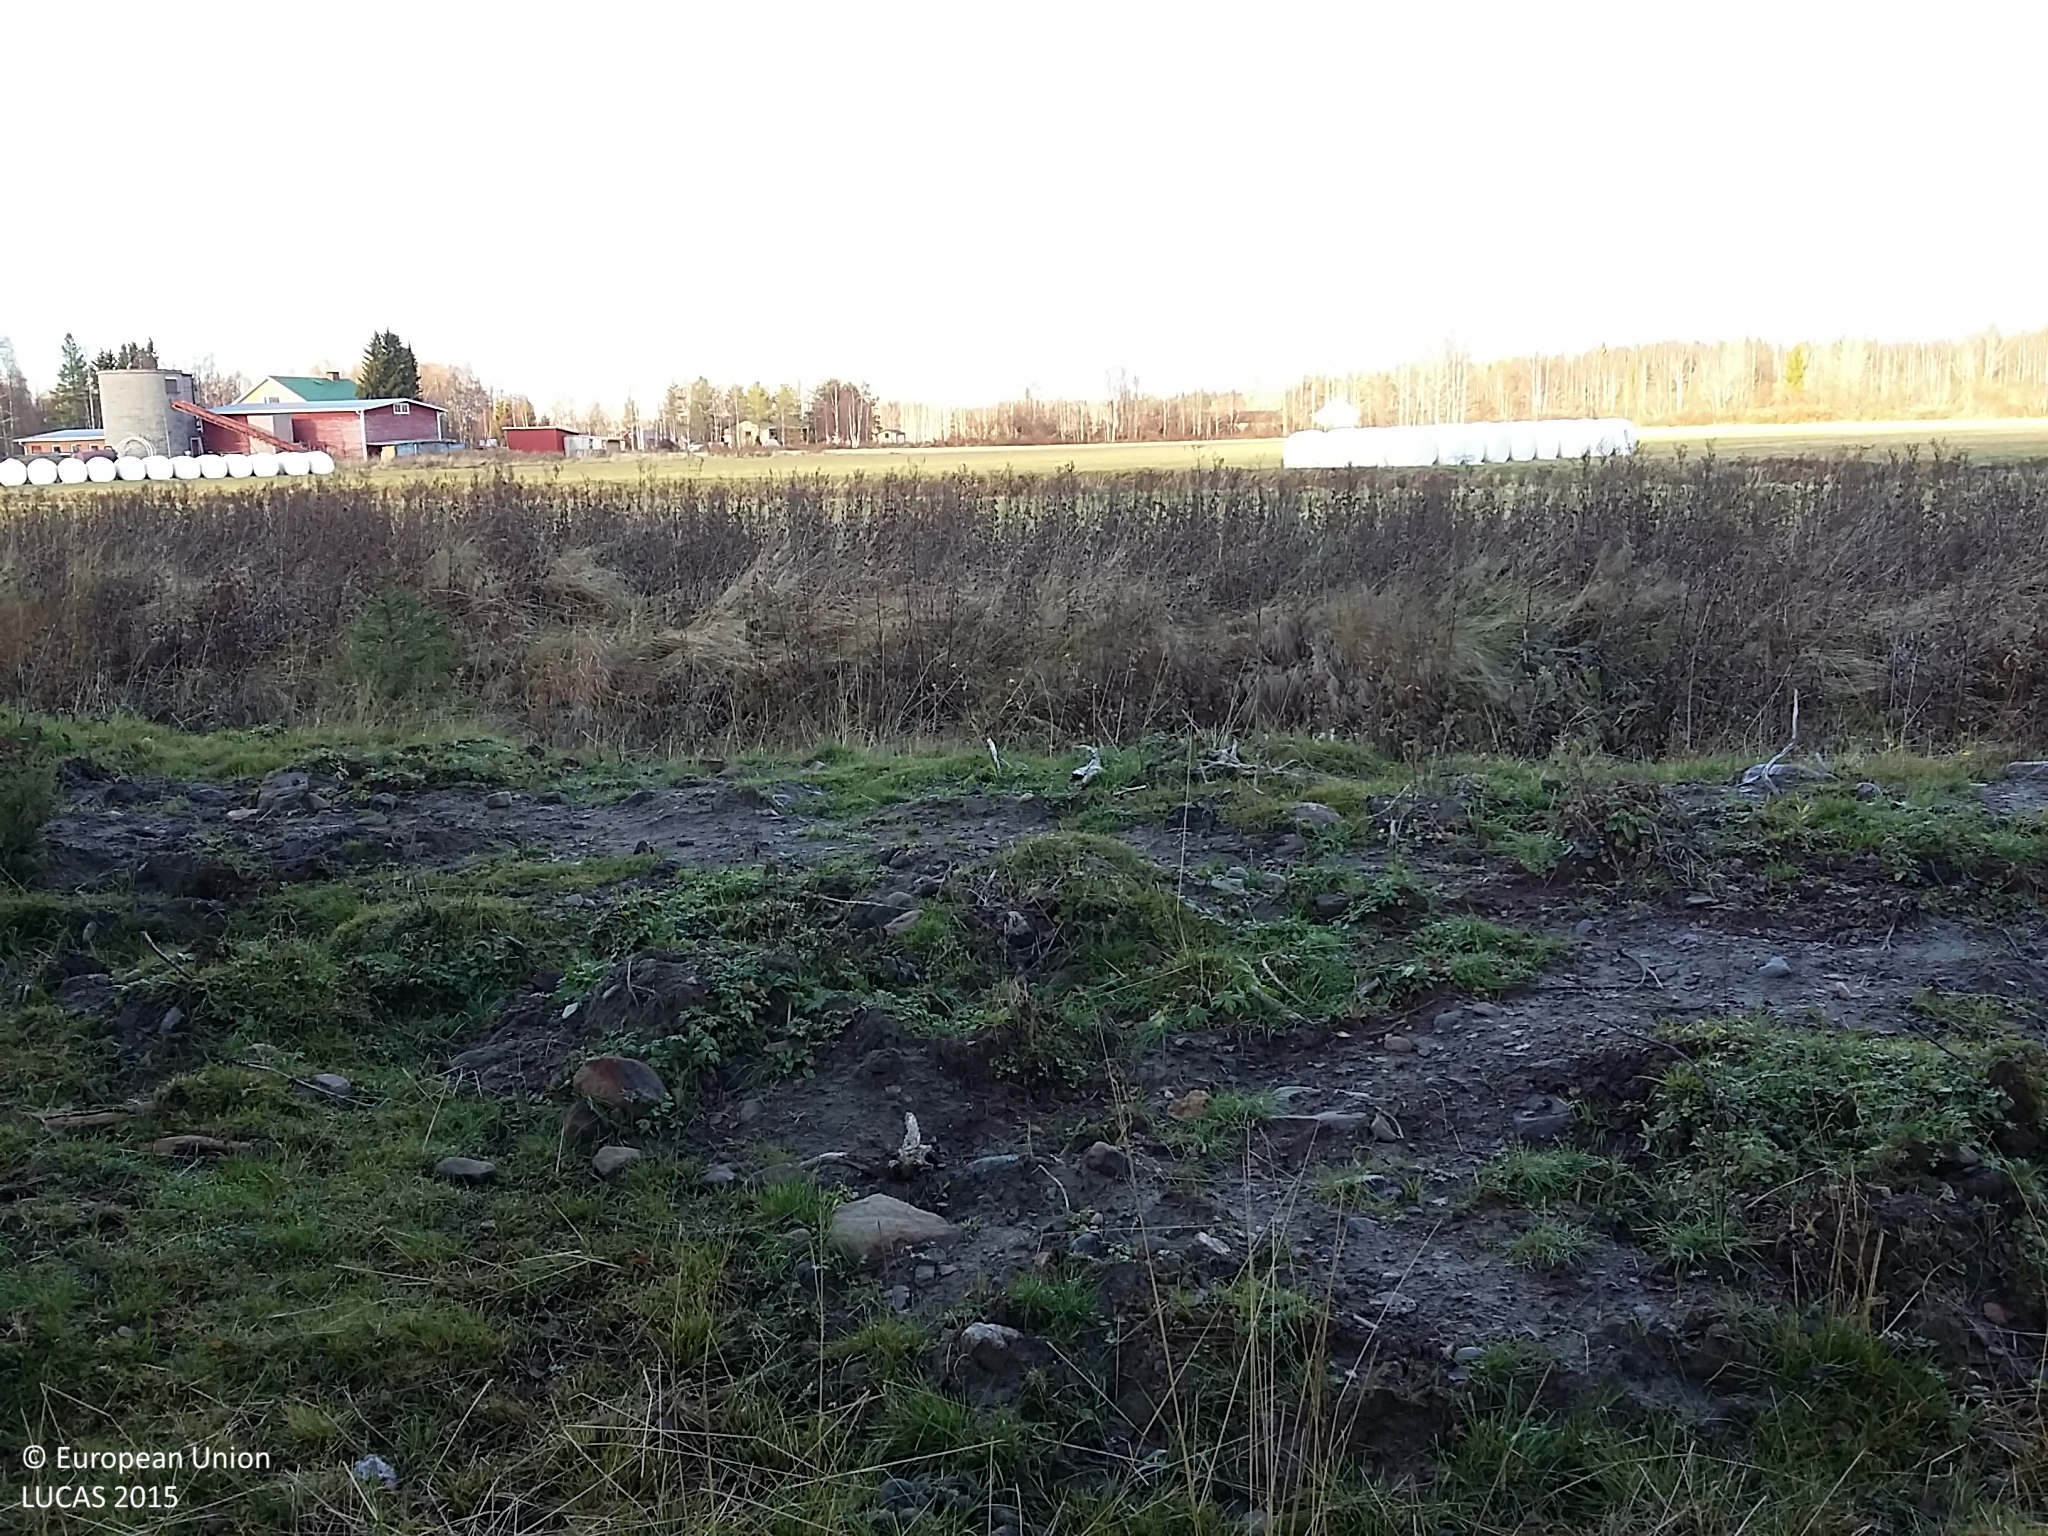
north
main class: Woodland
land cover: Spruce dominated coniferous woodland
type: boreal forest
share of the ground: 25 - 50 %
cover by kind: coniferous forest trees 40 %, shrubs 20 %, herbaceous plants 20 %, lichens and mosses 20 %
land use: Forestry
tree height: > 5 m
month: October
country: FI
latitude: 64.2089
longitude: 25.0597
